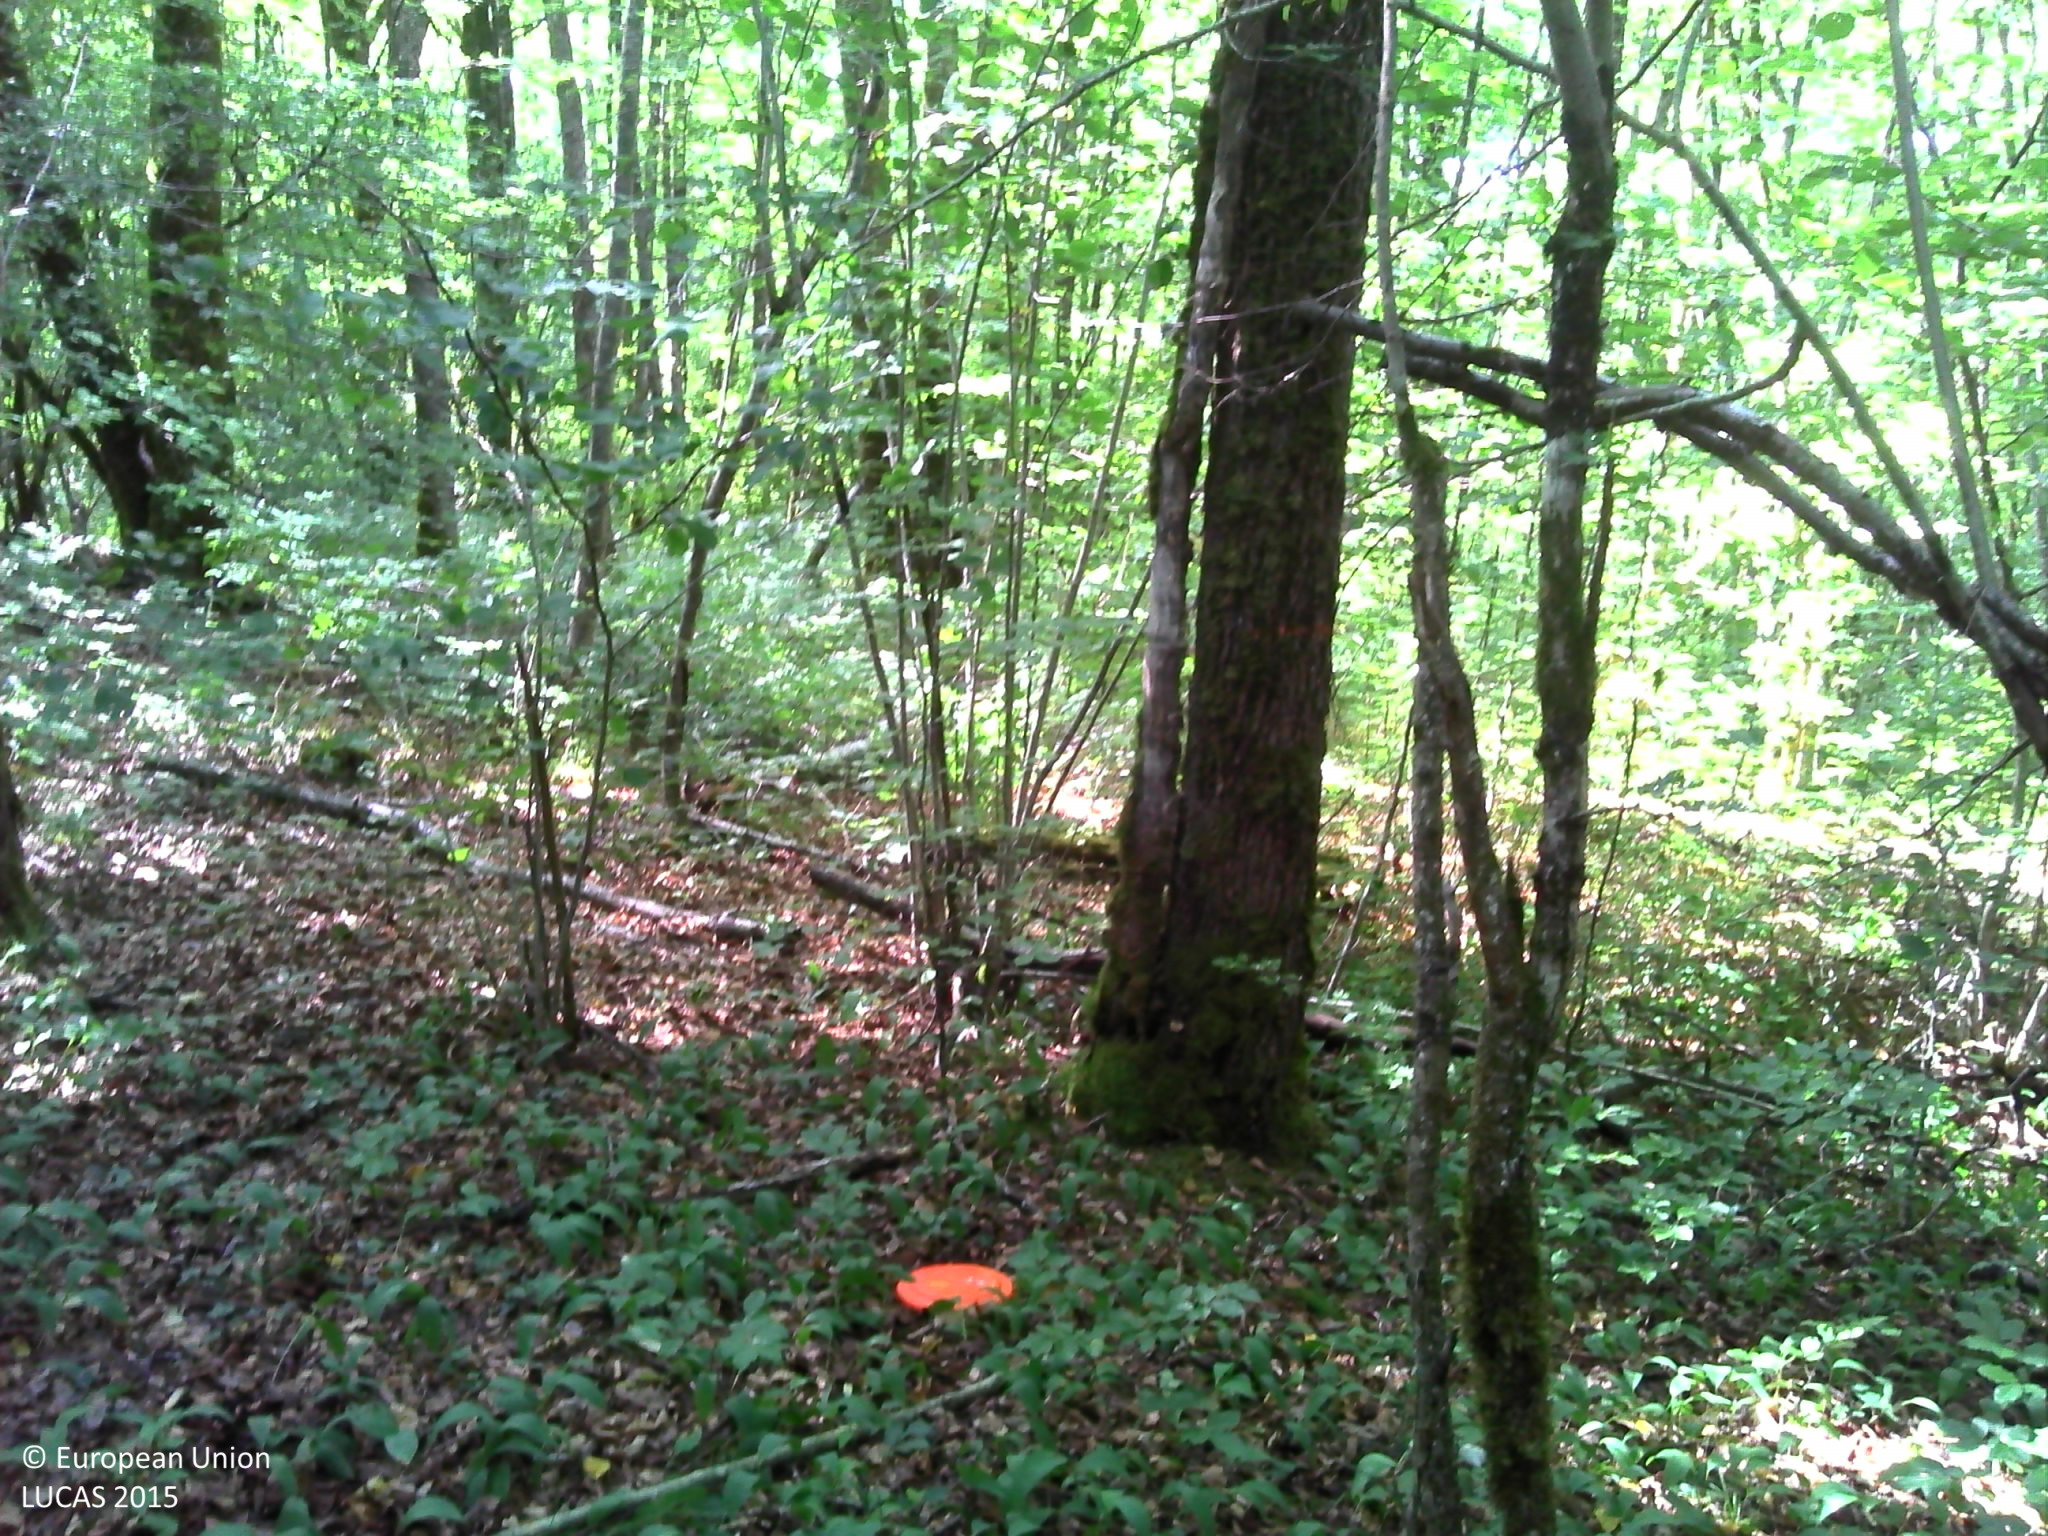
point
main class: Woodland
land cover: Broadleaved woodland
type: mesophytic deciduous forest
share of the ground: > 75 %
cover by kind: broadleaved forest trees 90 %, herbaceous plants 5 %, lichens and mosses 5 %
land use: Forestry
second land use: Amenities, museums, leisure
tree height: > 5 m
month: August
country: FR
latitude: 47.8100
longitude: 4.7510
